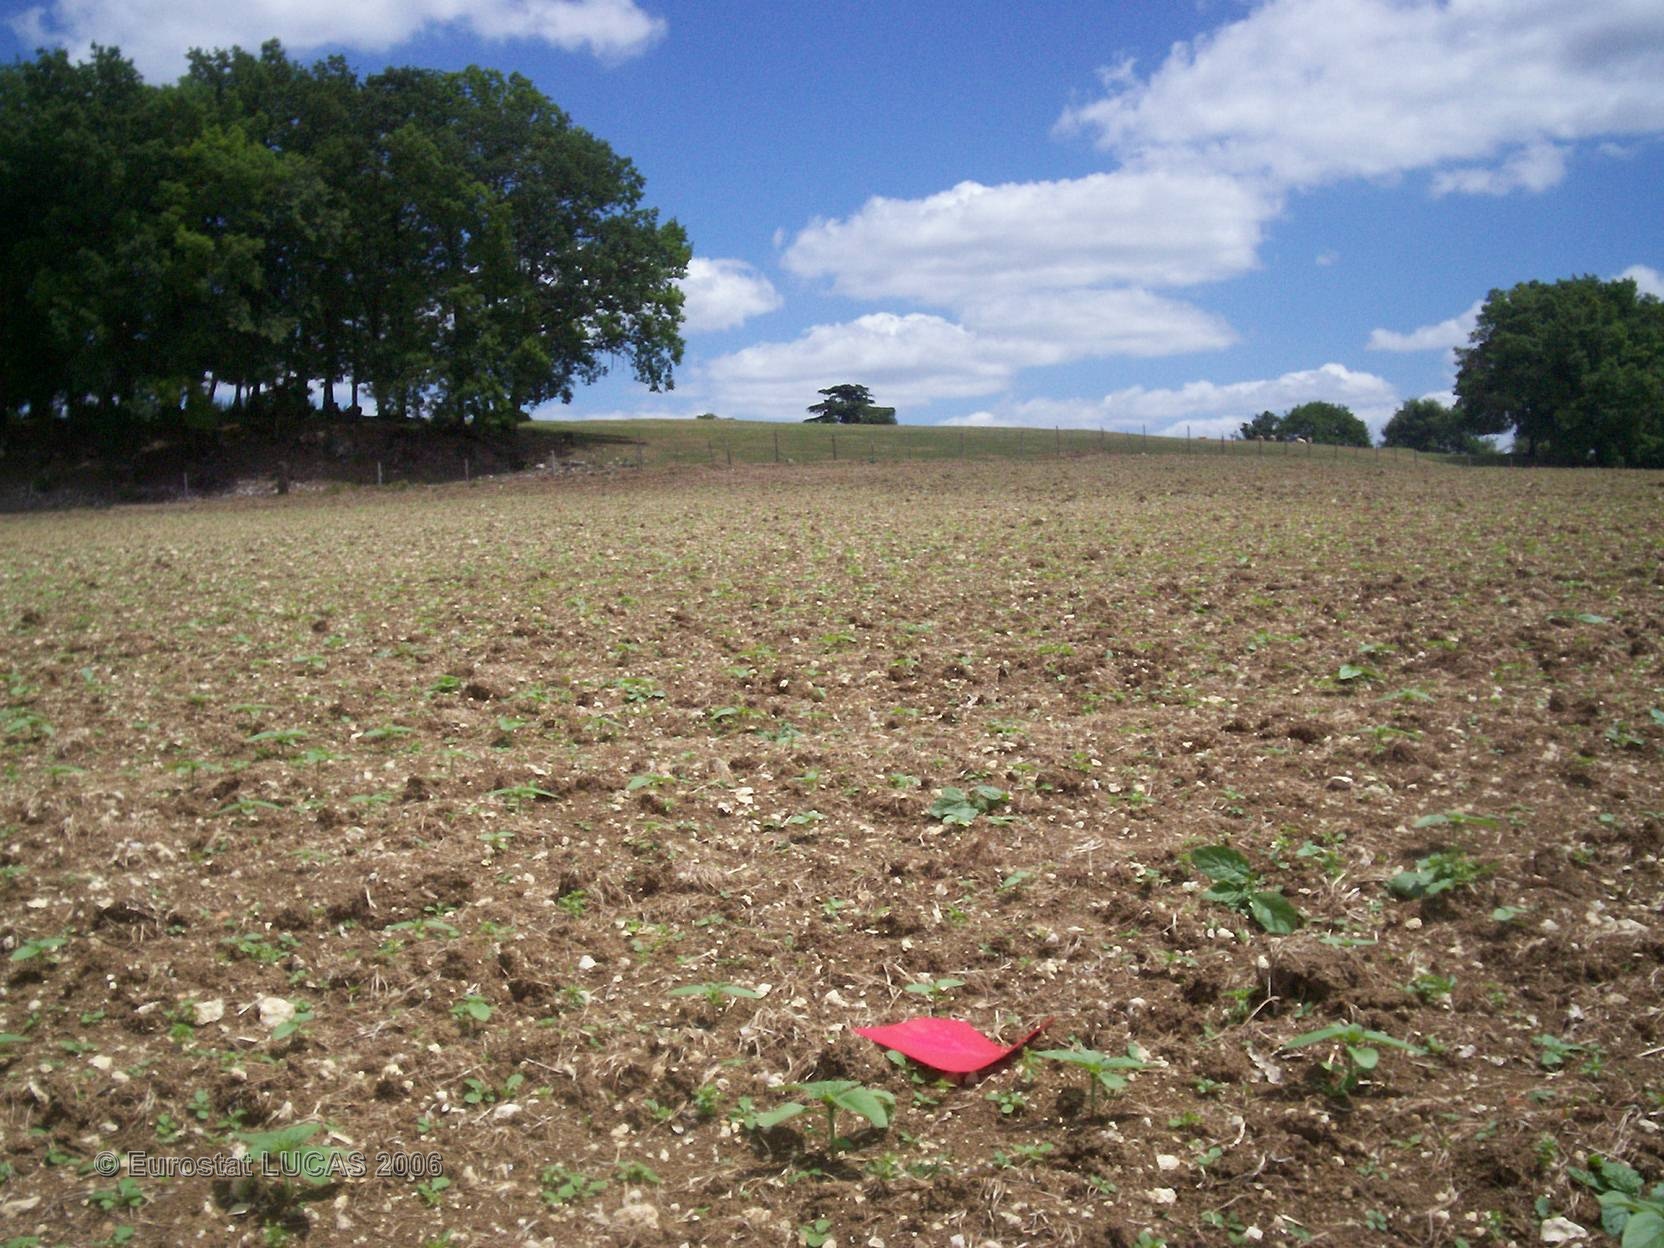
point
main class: Cropland
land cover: Sunflower
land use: Agriculture (excluding fallow land and kitchen gardens)
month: May
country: FR
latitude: 44.2732
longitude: 0.8625
